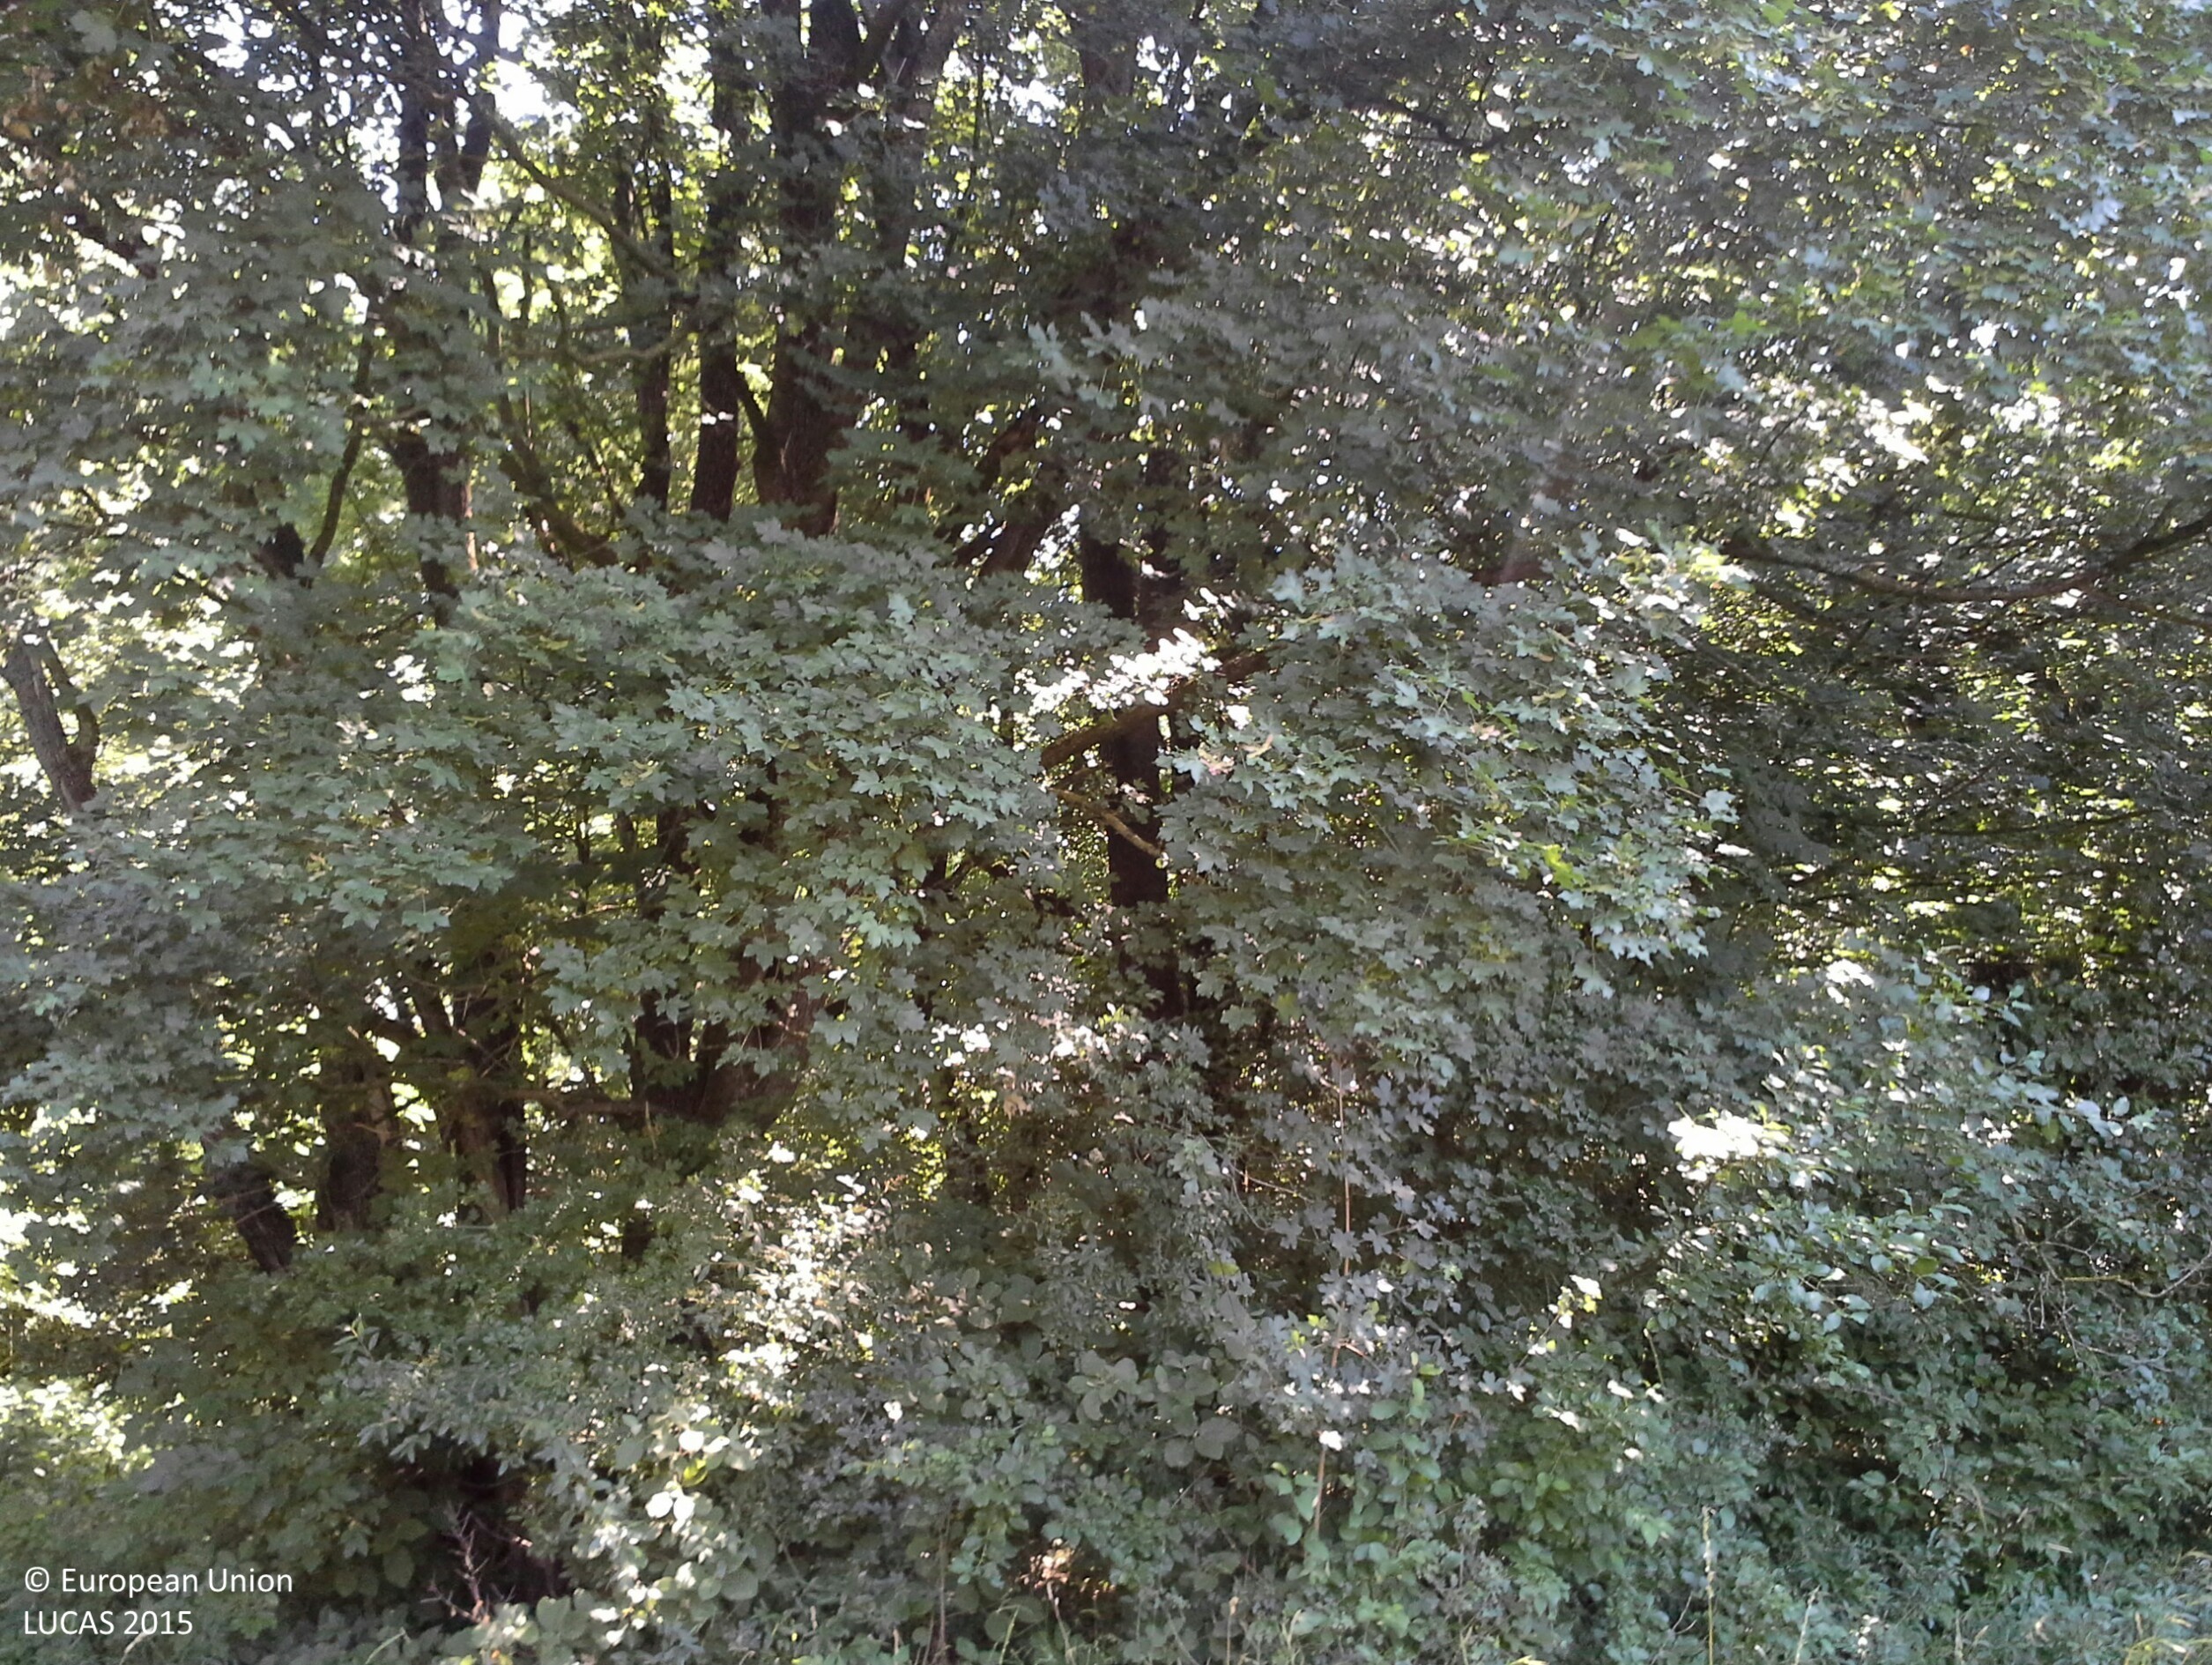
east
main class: Woodland
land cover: Broadleaved woodland
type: mesophytic deciduous forest
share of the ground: > 75 %
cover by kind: broadleaved forest trees 70 %, shrubs 15 %, herbaceous plants 15 %
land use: Forestry
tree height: < 5 m
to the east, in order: Broadleaved woodland; Grass margins; Broadleaved woodland; Grass margins; Fences; Broadleaved woodland; Fences; Grassland without tree/shrub cover; Paved roads, cycling and walking lanes; Grass margins; Lines of trees; Grassland without tree/shrub cover
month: July
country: AT
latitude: 48.0989
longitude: 14.8483
